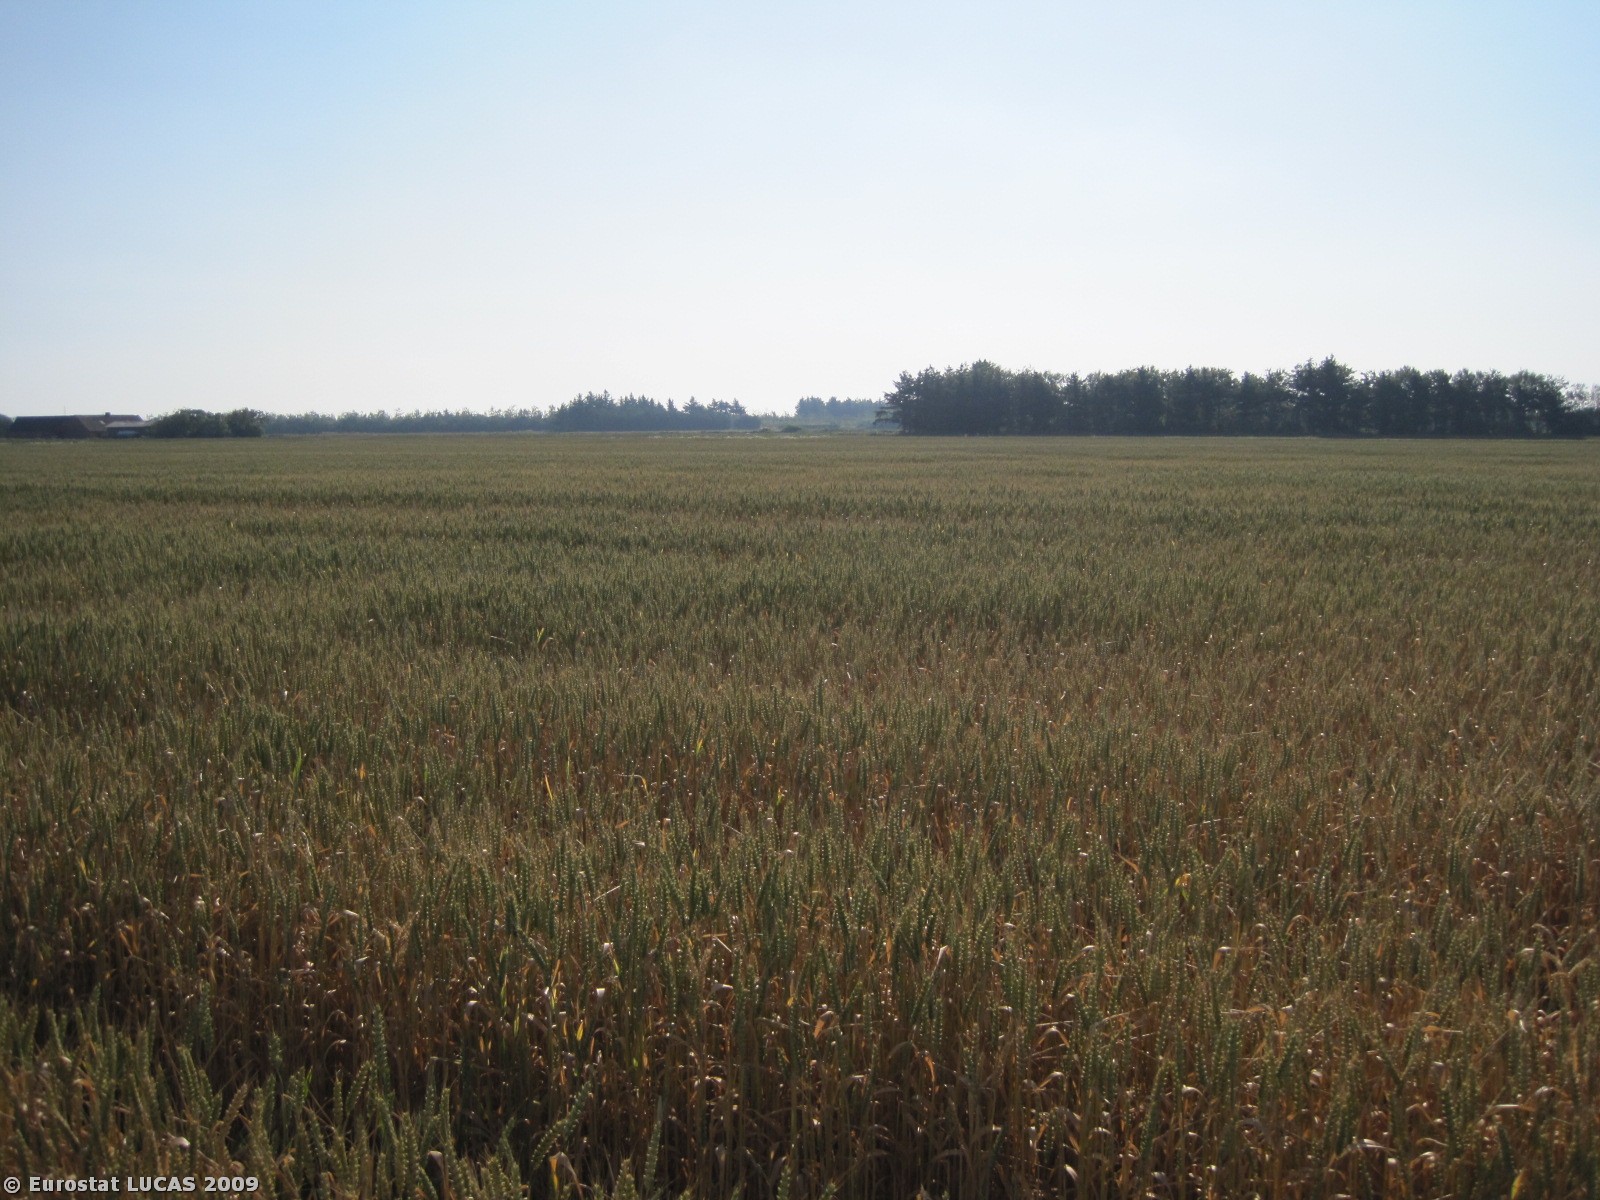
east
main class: Cropland
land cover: Common wheat
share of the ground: > 75 %
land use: Agriculture (excluding fallow land and kitchen gardens)
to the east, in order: Common wheat; Grass margins; Fences; Grassland without tree/shrub cover; Fences; Temporary grasslands
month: July
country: DK
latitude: 56.3730
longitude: 8.2048
